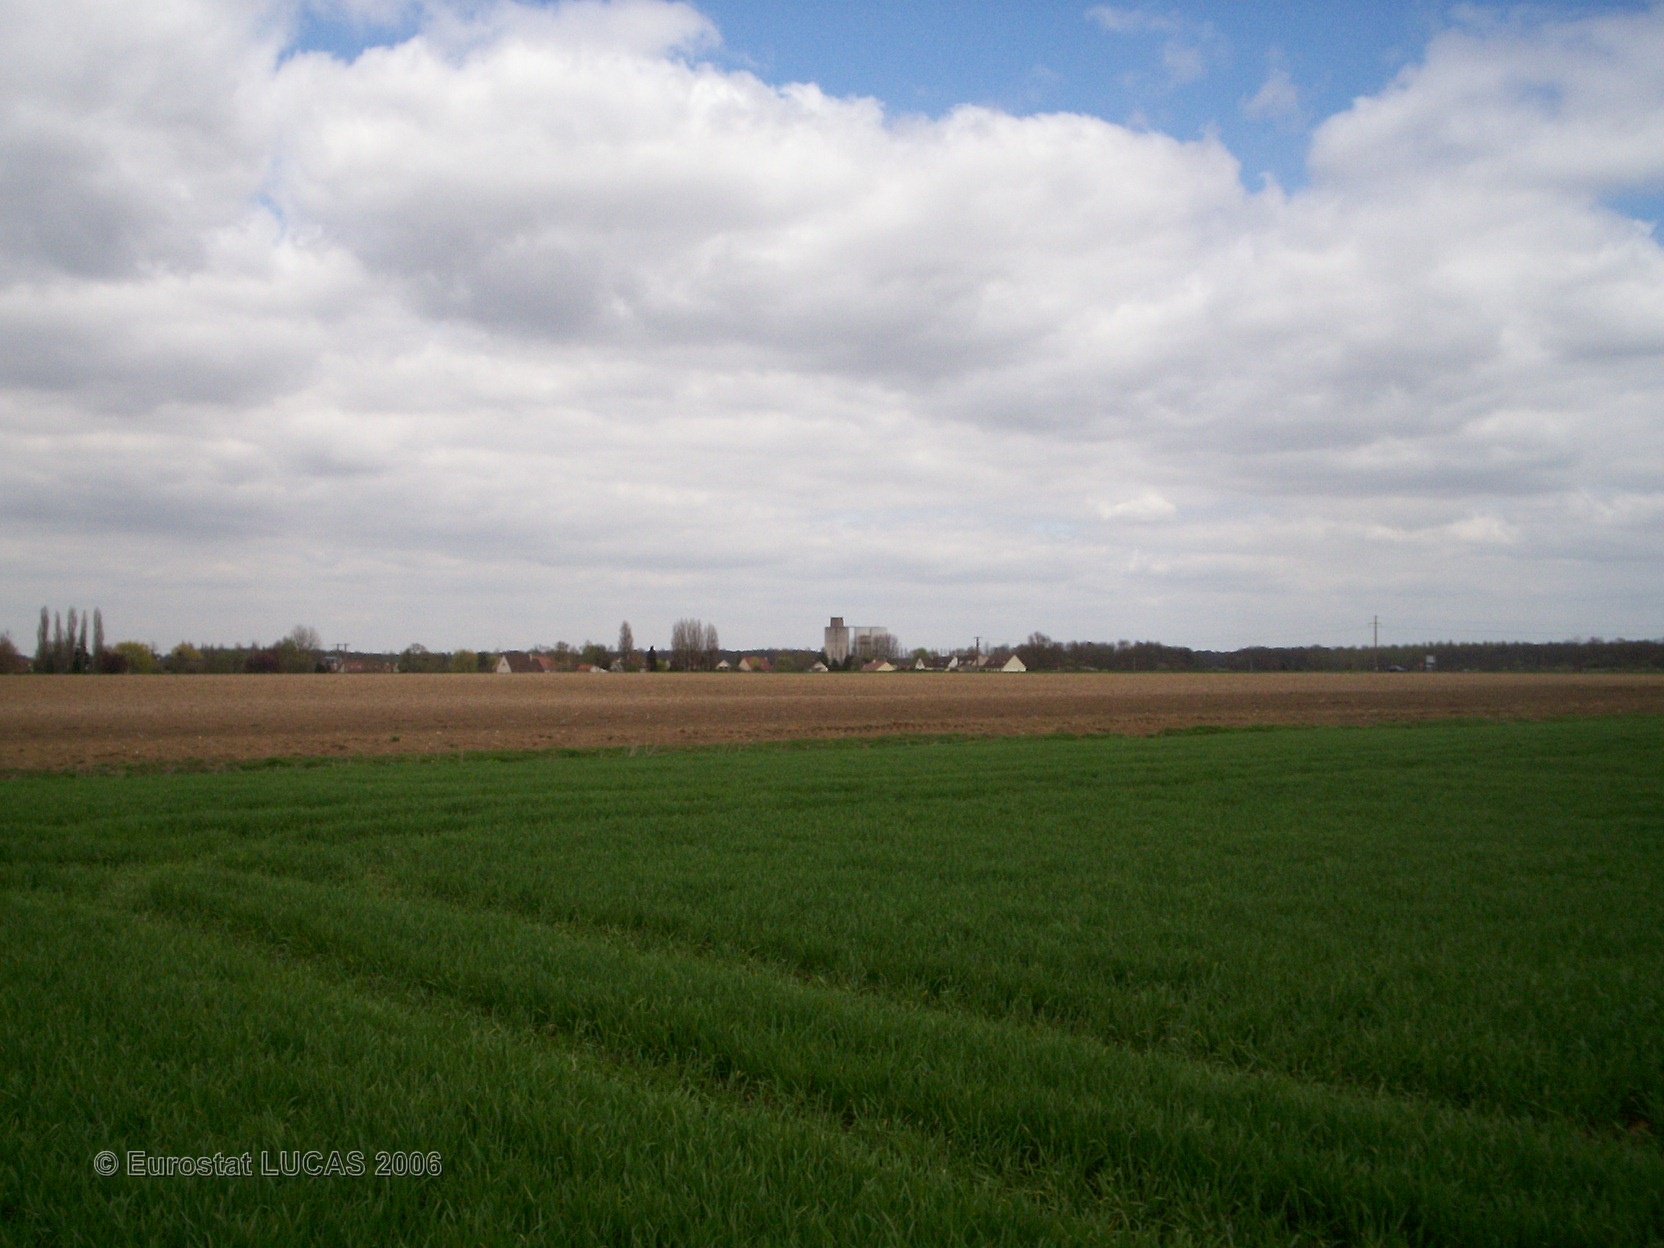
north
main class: Cropland
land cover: Common wheat
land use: Agriculture (excluding fallow land and kitchen gardens)
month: April
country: FR
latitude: 48.4976
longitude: 2.8593
